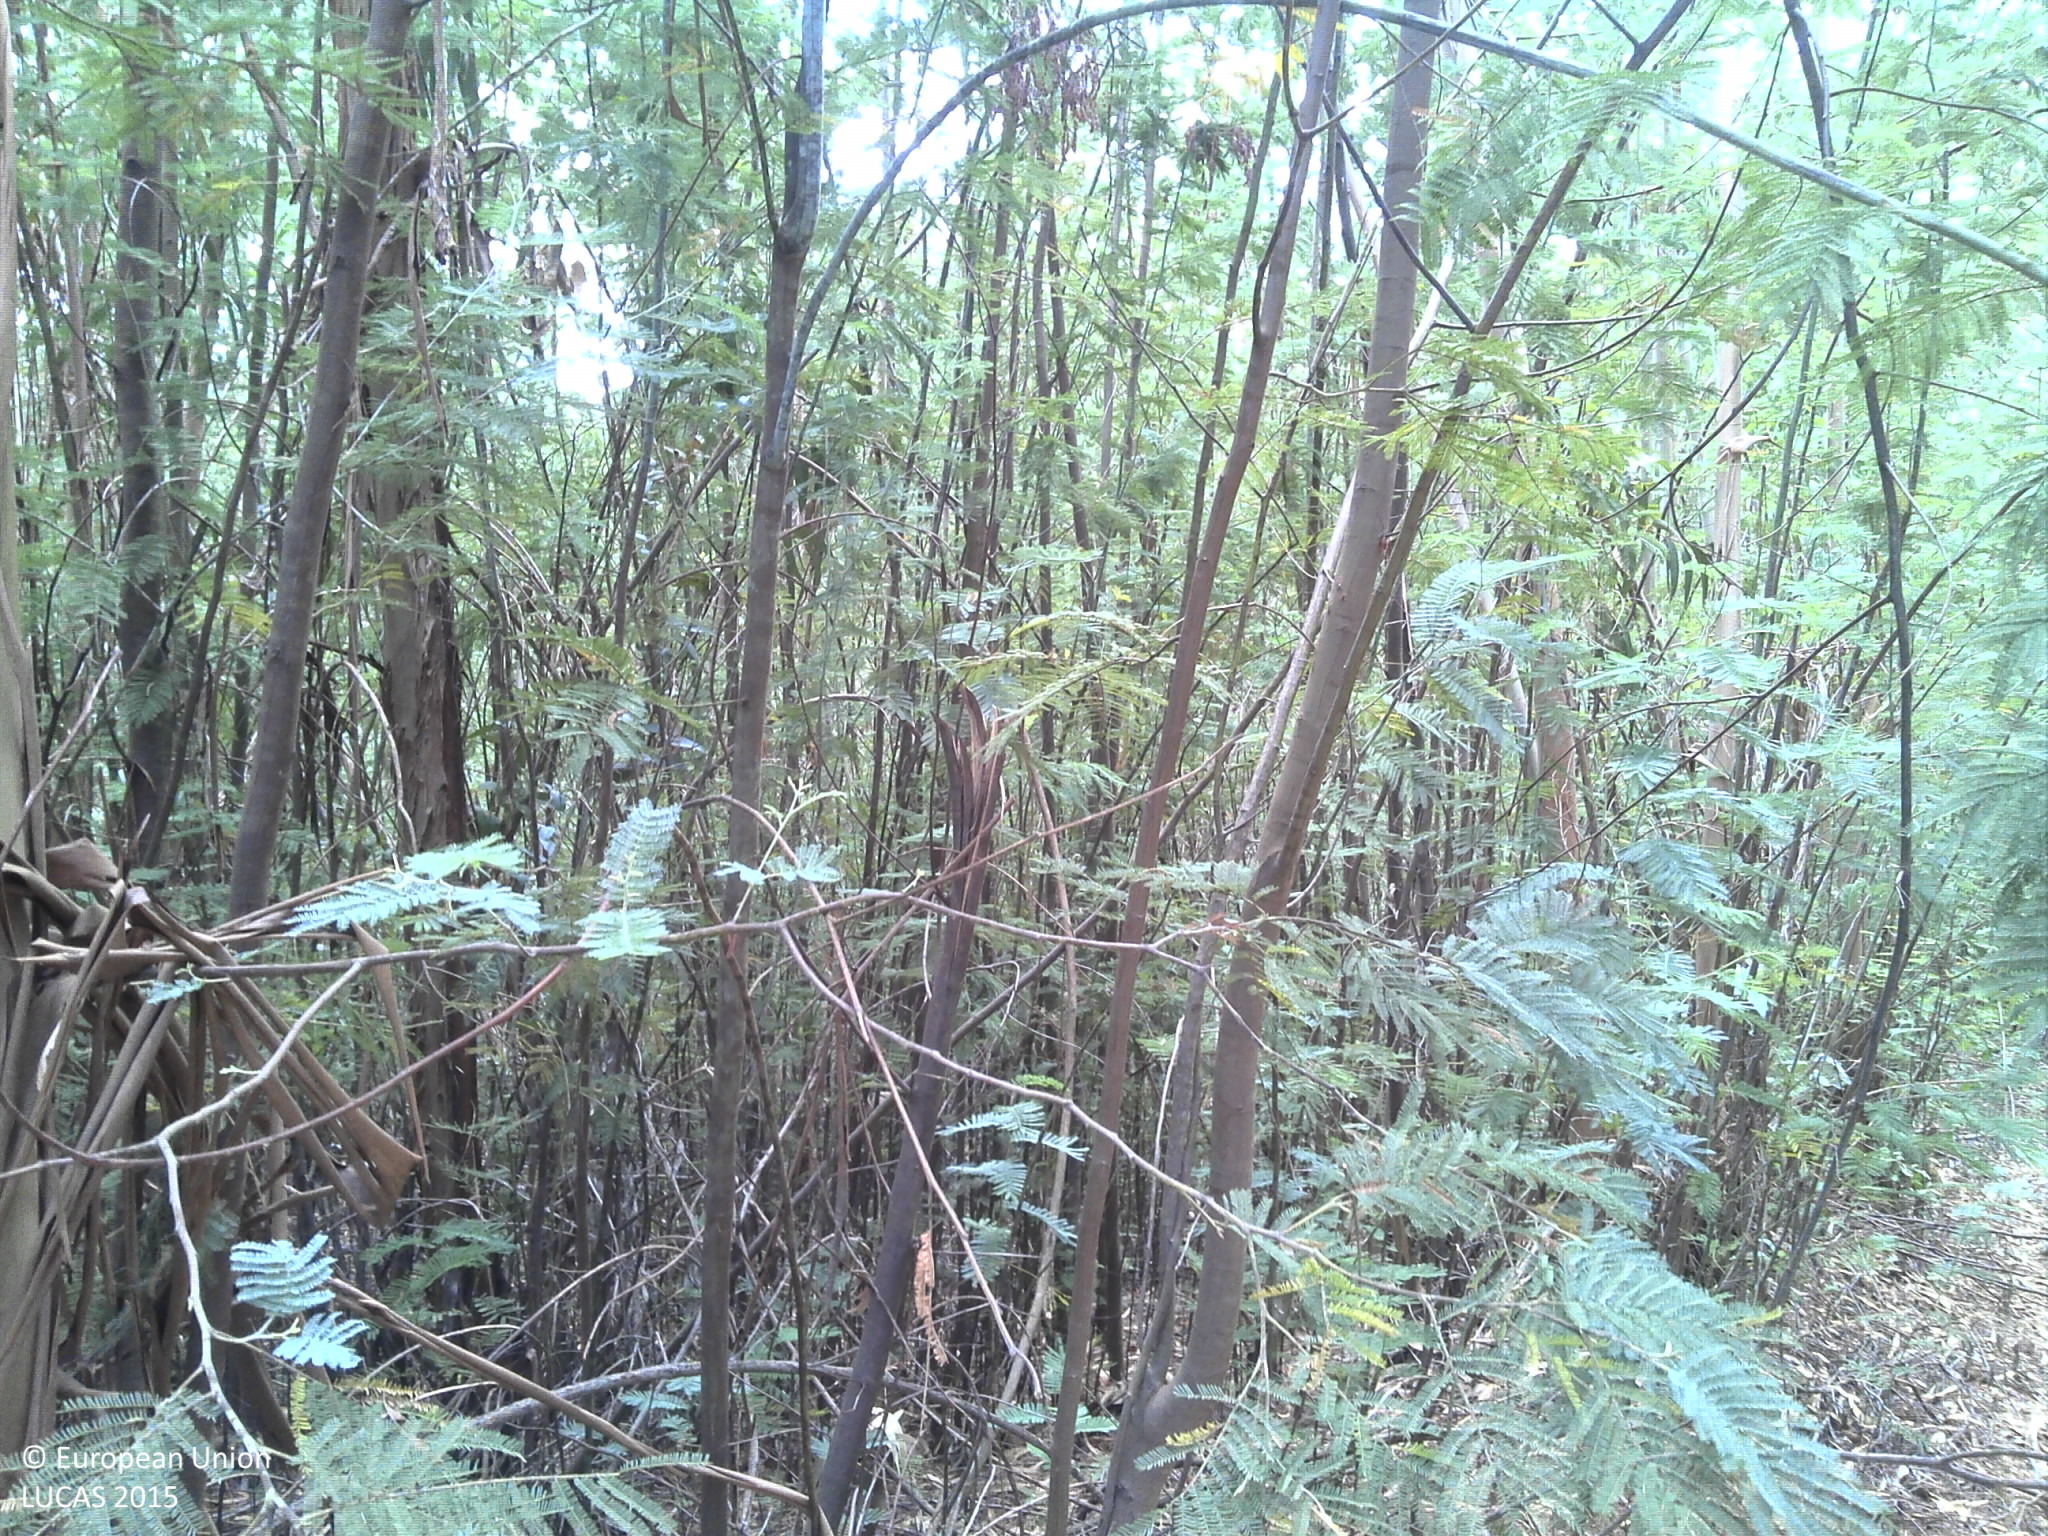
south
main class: Woodland
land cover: Broadleaved woodland
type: exotic forest
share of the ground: > 75 %
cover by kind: broadleaved forest trees 80 %, unconsolidated bare surface 15 %, shrubs 5 %
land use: Forestry
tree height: > 5 m
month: July
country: PT
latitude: 40.3118
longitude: -8.1638
